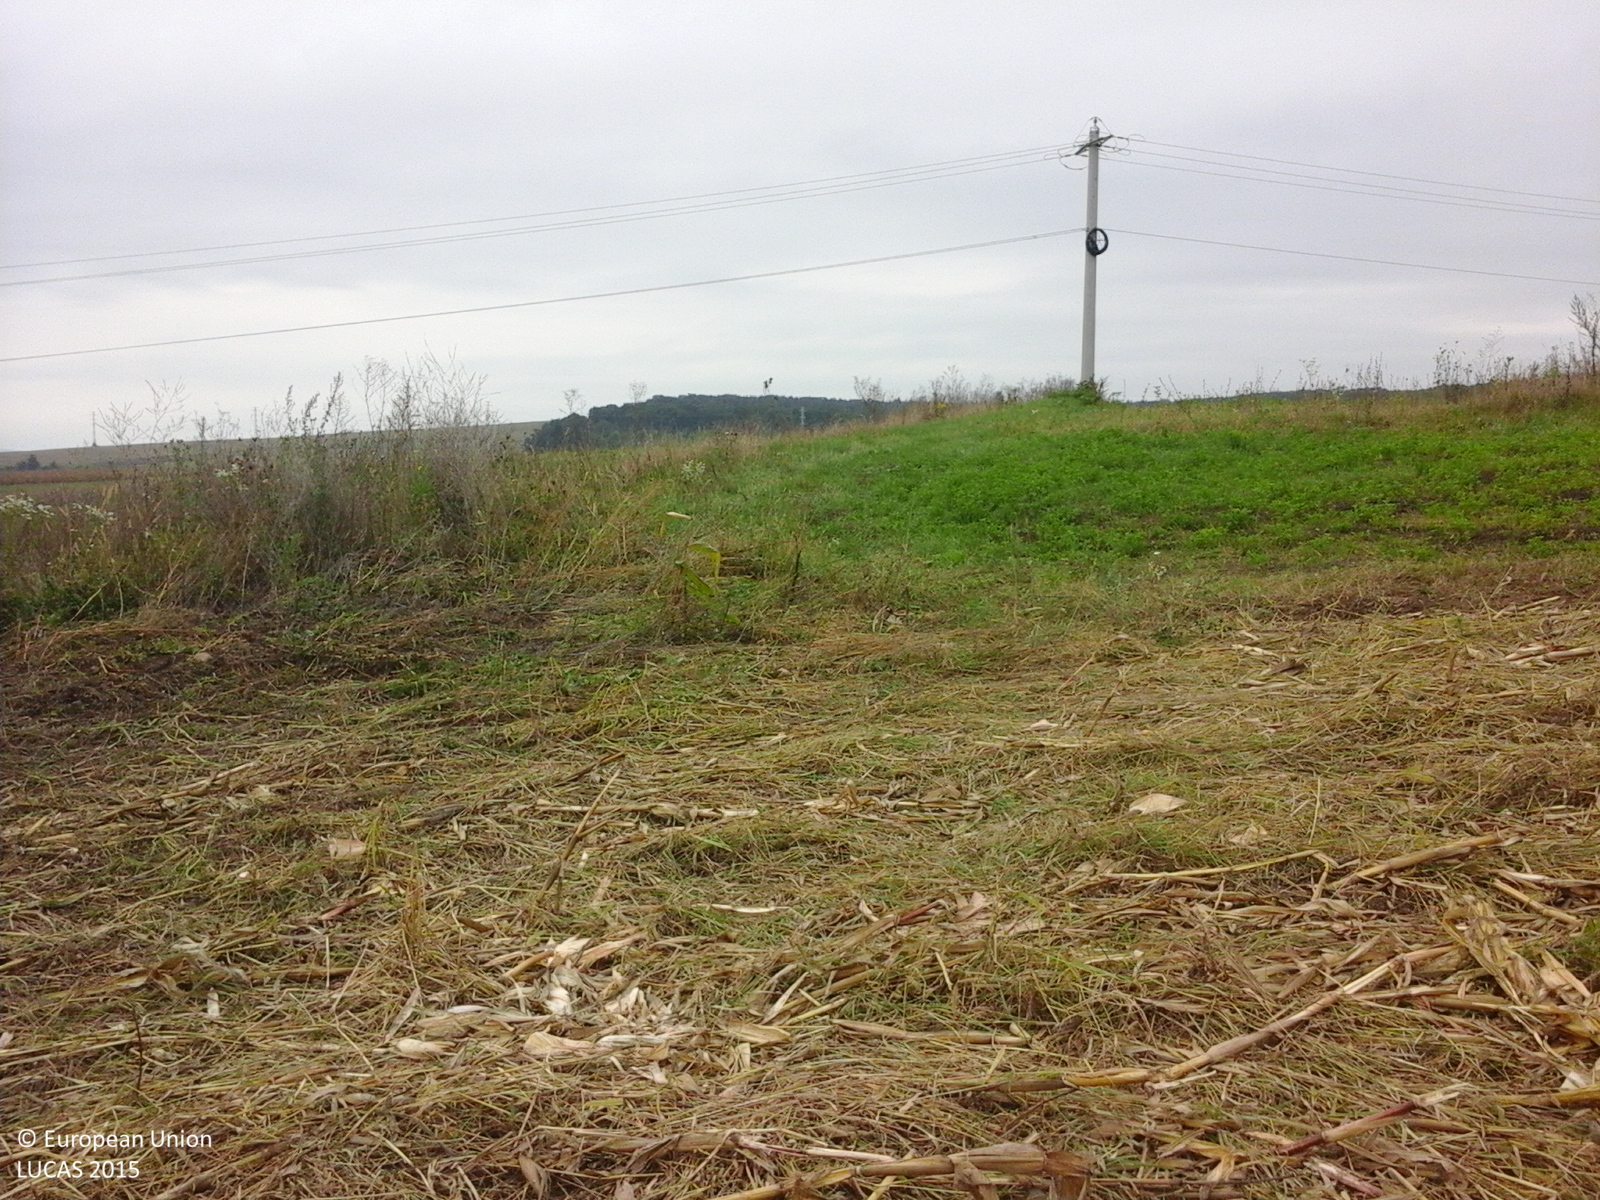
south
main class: Cropland
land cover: Maize
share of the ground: 25 - 50 %
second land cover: Spontaneously vegetated surfaces
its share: 25 - 50 %
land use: Agriculture (excluding fallow land and kitchen gardens)
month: October
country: RO
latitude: 46.0364
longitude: 25.2559
